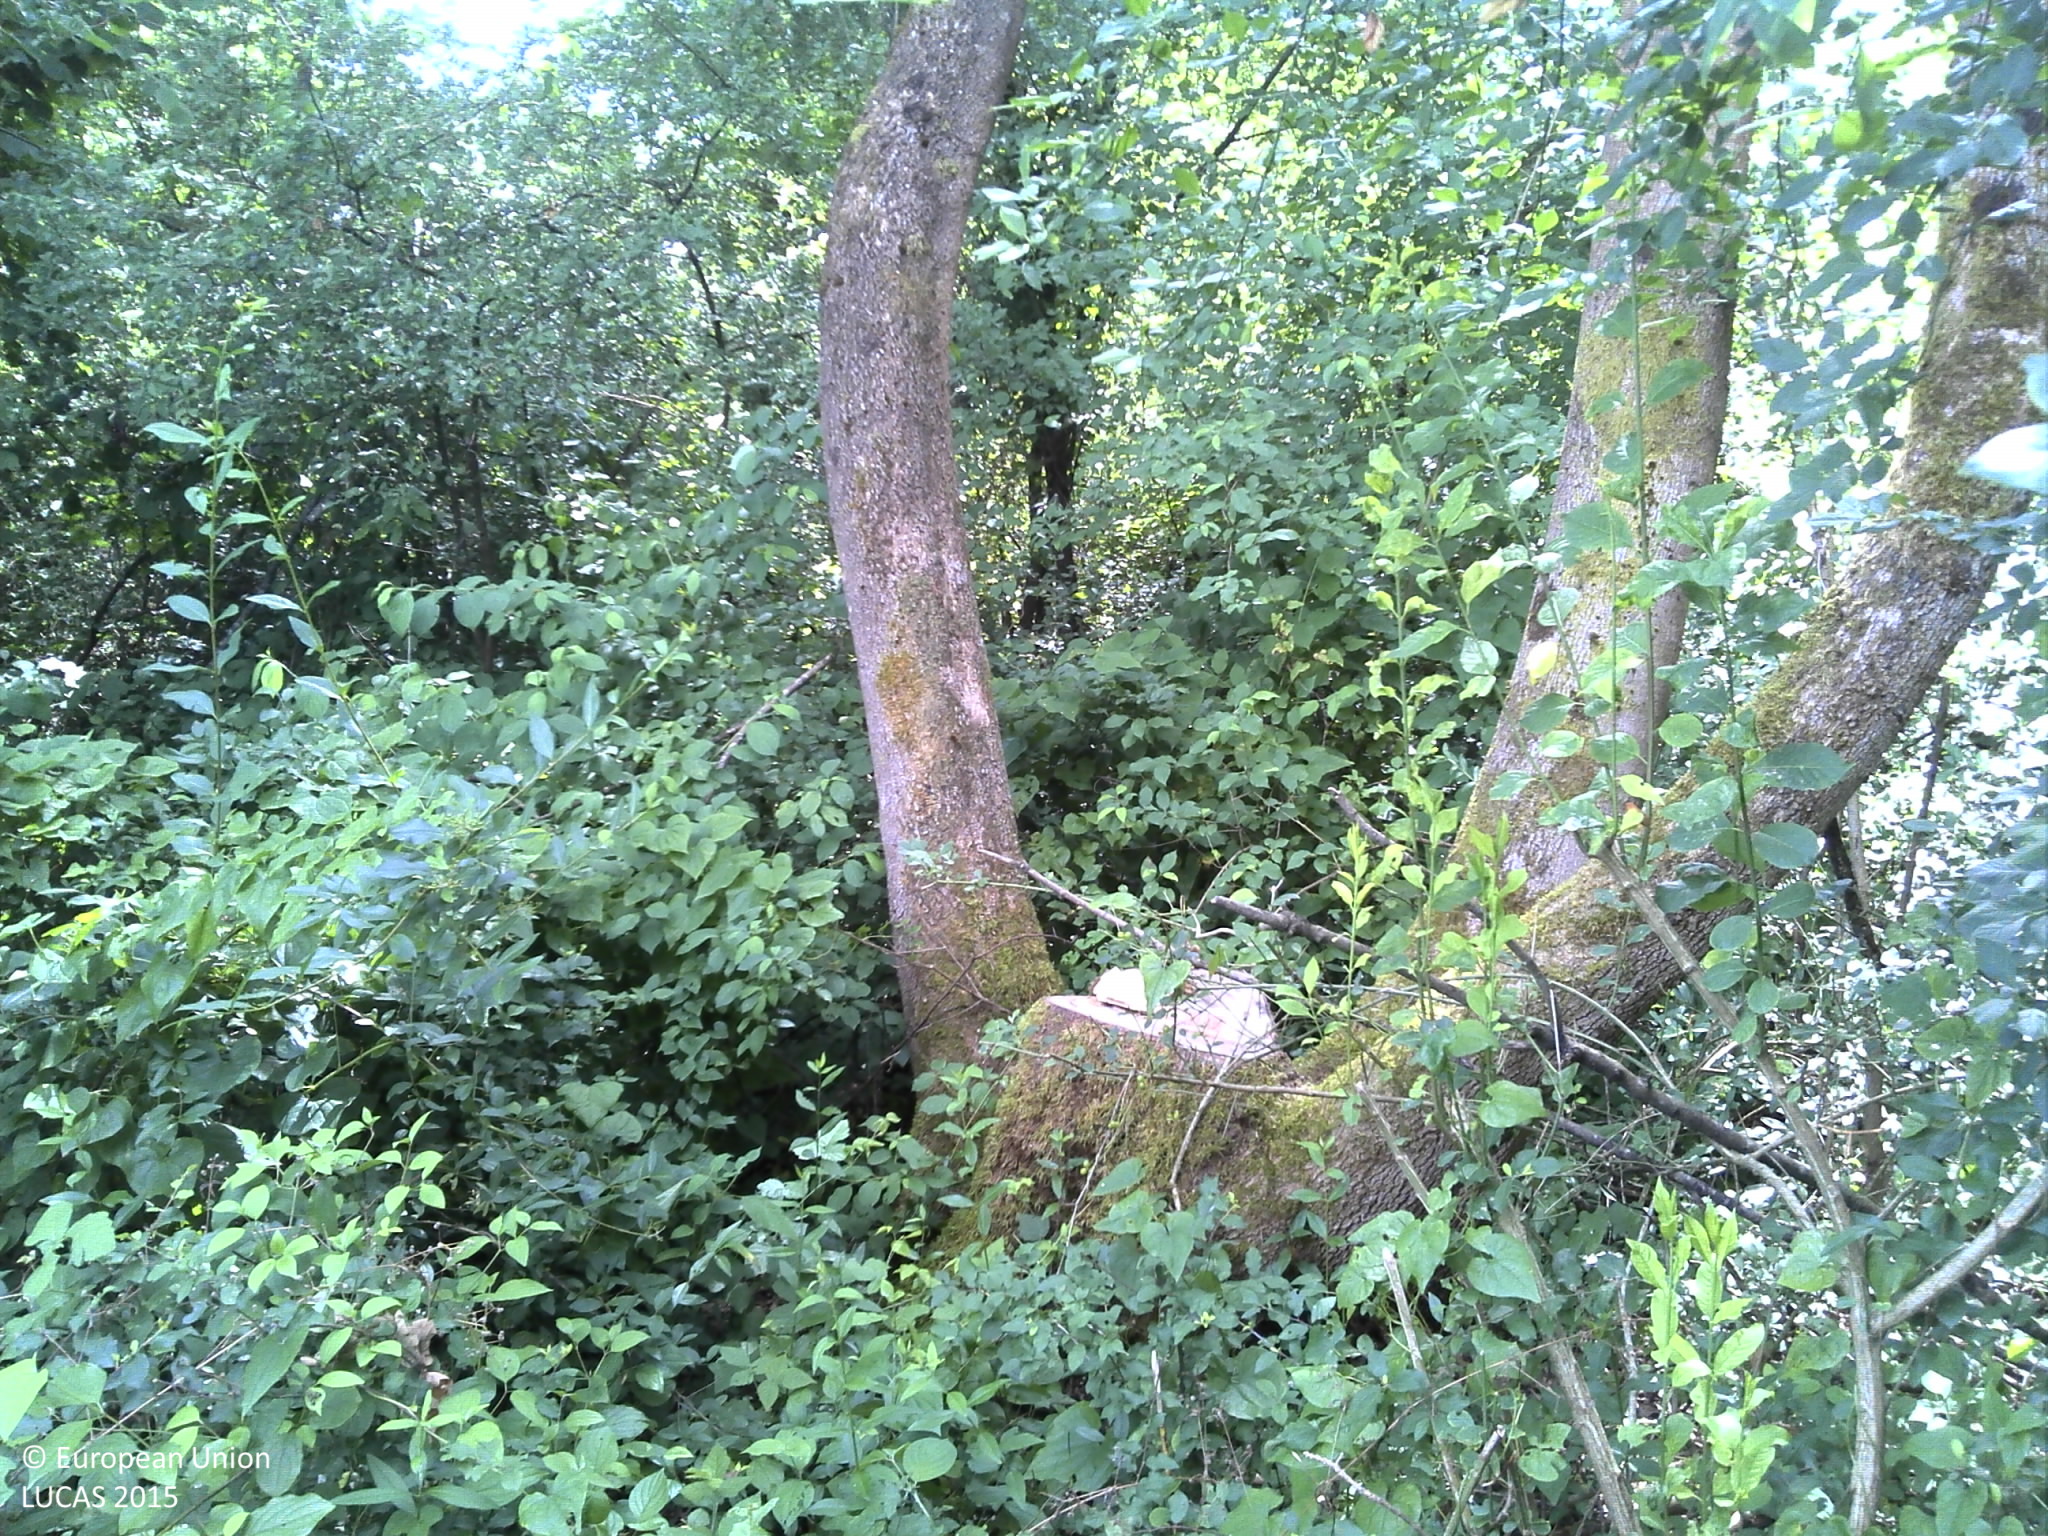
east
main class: Woodland
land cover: Broadleaved woodland
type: acidophilous oak and oak-birch forest
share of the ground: 50 - 75 %
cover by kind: broadleaved forest trees 75 %, shrubs 25 %
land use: Forestry
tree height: > 5 m
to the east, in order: Broadleaved woodland; Shrubland without tree cover; Broadleaved woodland; Tracks; Shrubland without tree cover; Ditches and canals; Shrubland with sparse tree cover; Common wheat; Broadleaved woodland; Maize
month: June
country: HR
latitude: 45.1019
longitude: 17.8680
